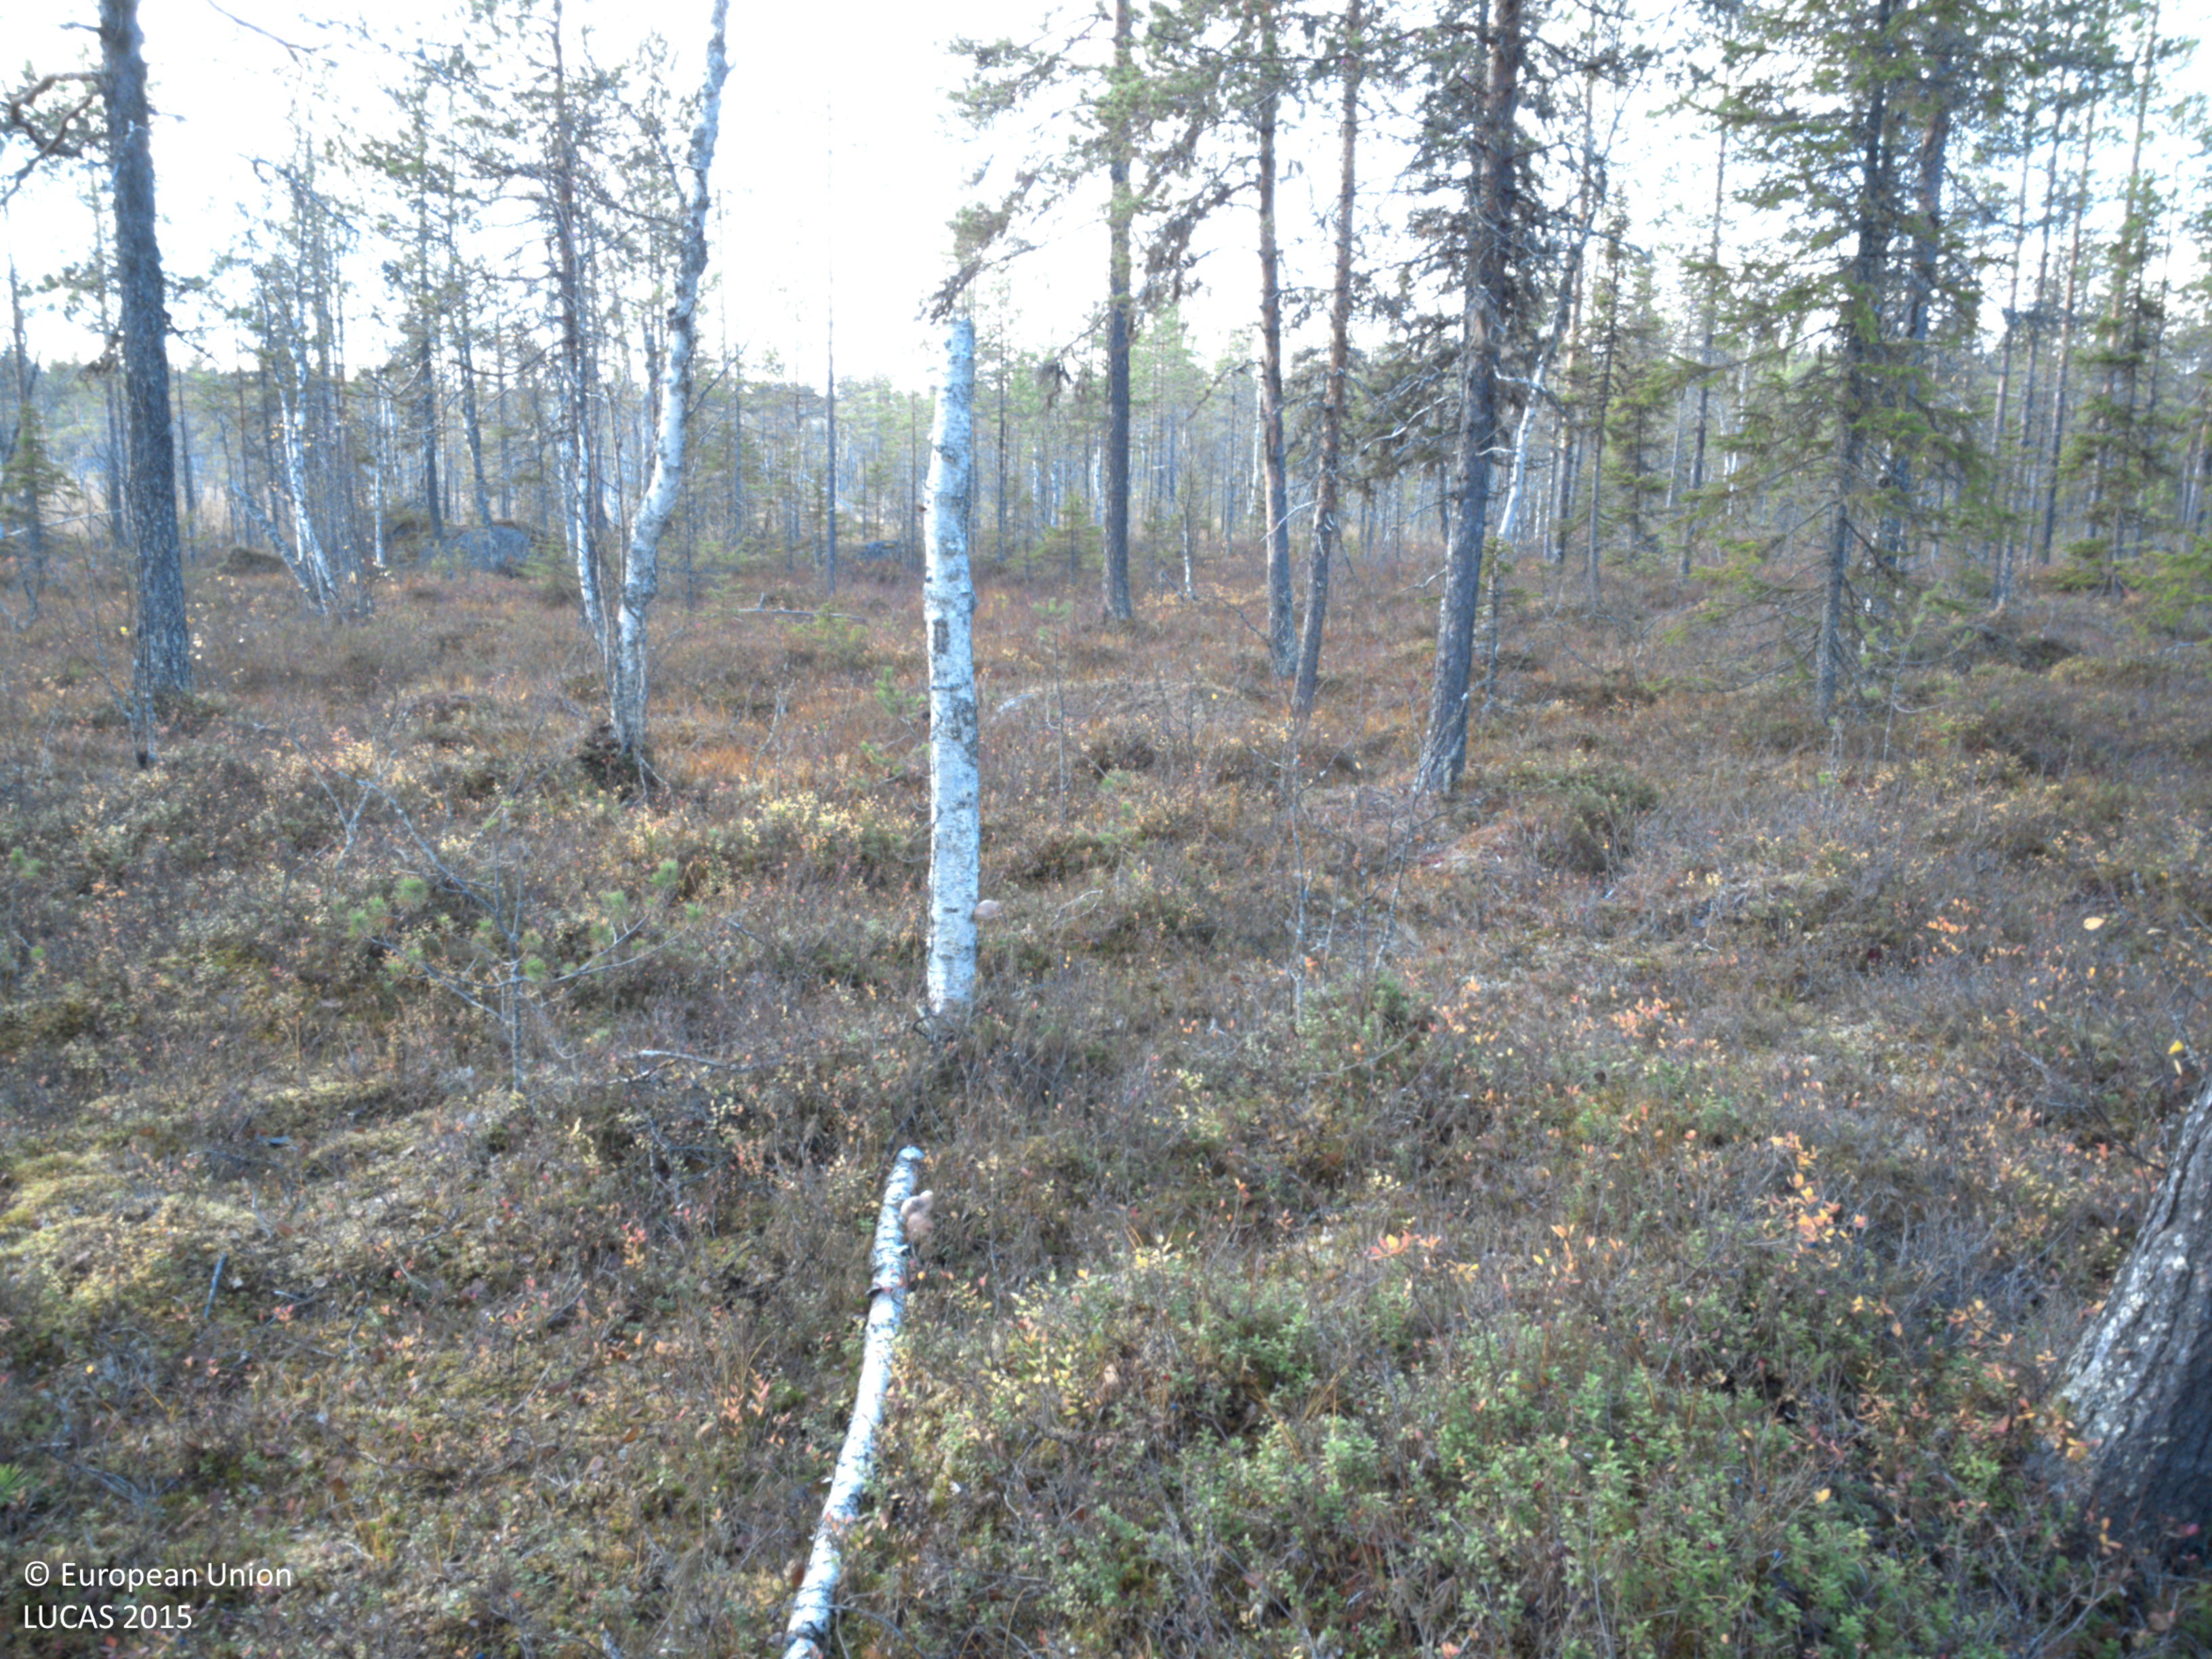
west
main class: Woodland
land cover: Pine dominated coniferous woodland
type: mire and swamp forests
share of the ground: 50 - 75 %
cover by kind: coniferous forest trees 75 %, shrubs 15 %, lichens and mosses 10 %
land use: Forestry
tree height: > 5 m
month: October
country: SE
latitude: 64.8957
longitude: 18.1821
